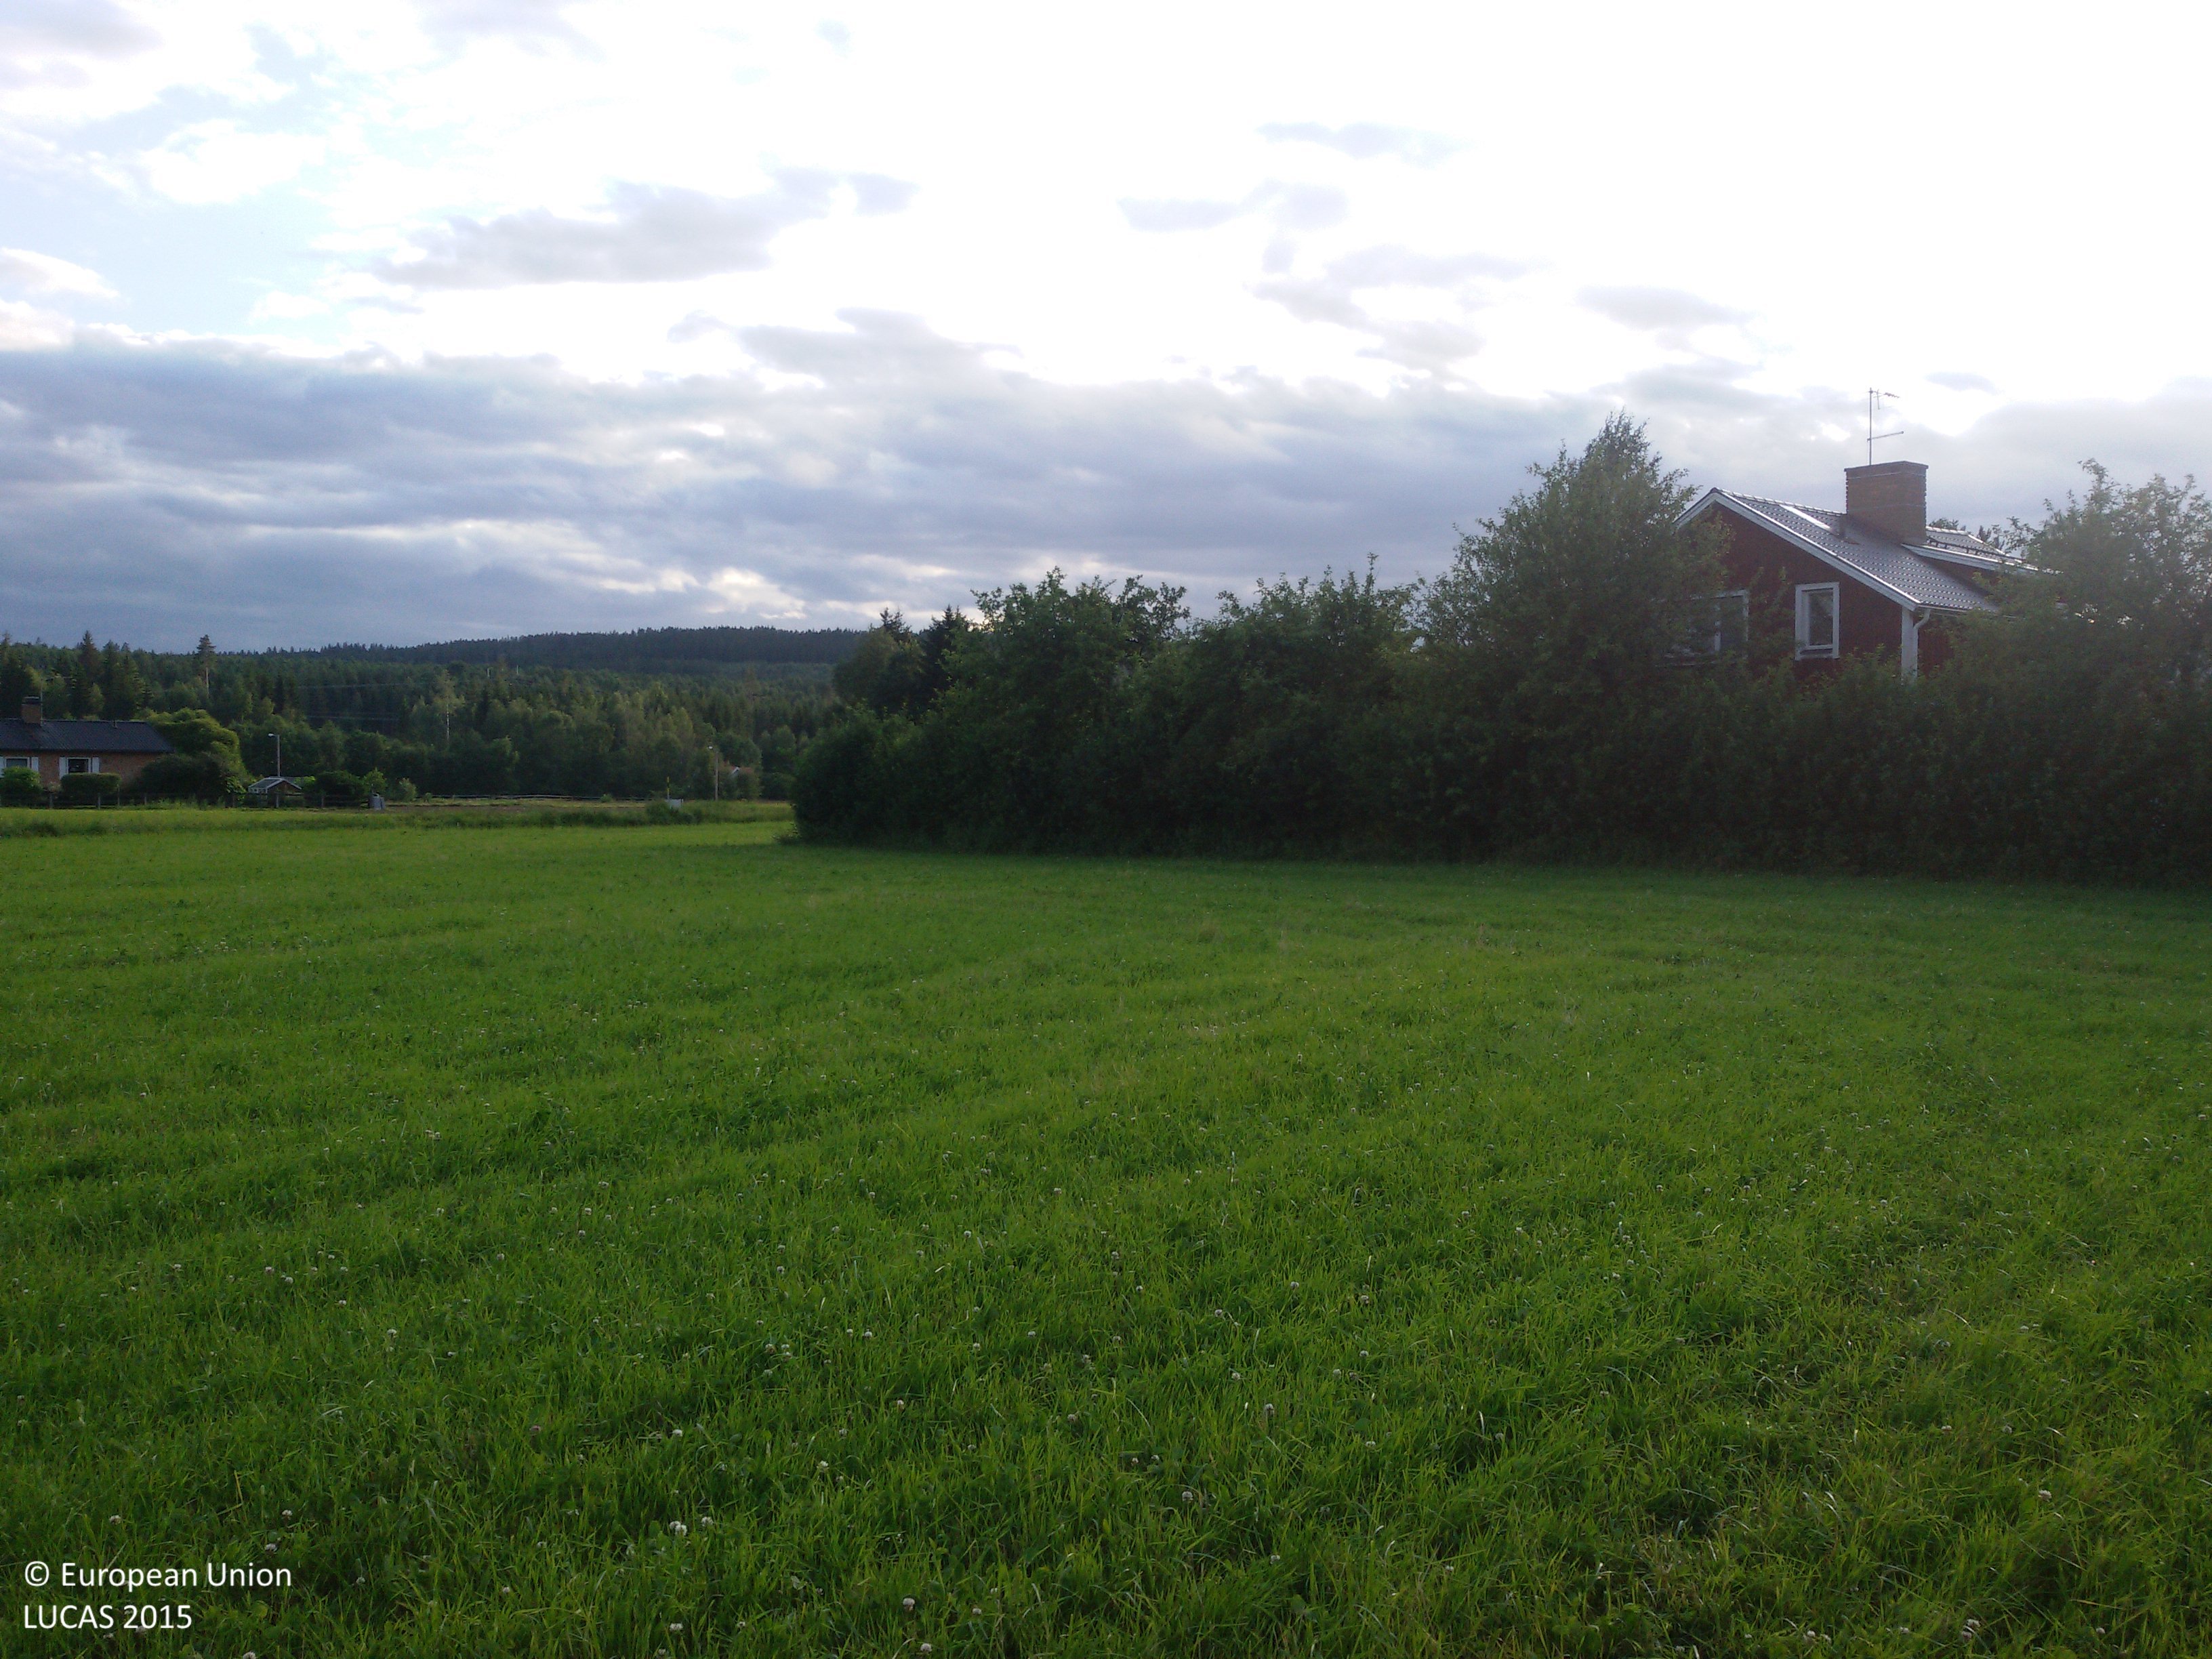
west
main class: Grassland
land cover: Grassland without tree/shrub cover
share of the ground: > 75 %
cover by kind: herbaceous plants 100 %
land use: Agriculture (excluding fallow land and kitchen gardens)
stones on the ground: < 10 %
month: July
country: SE
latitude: 60.5120
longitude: 15.3603
